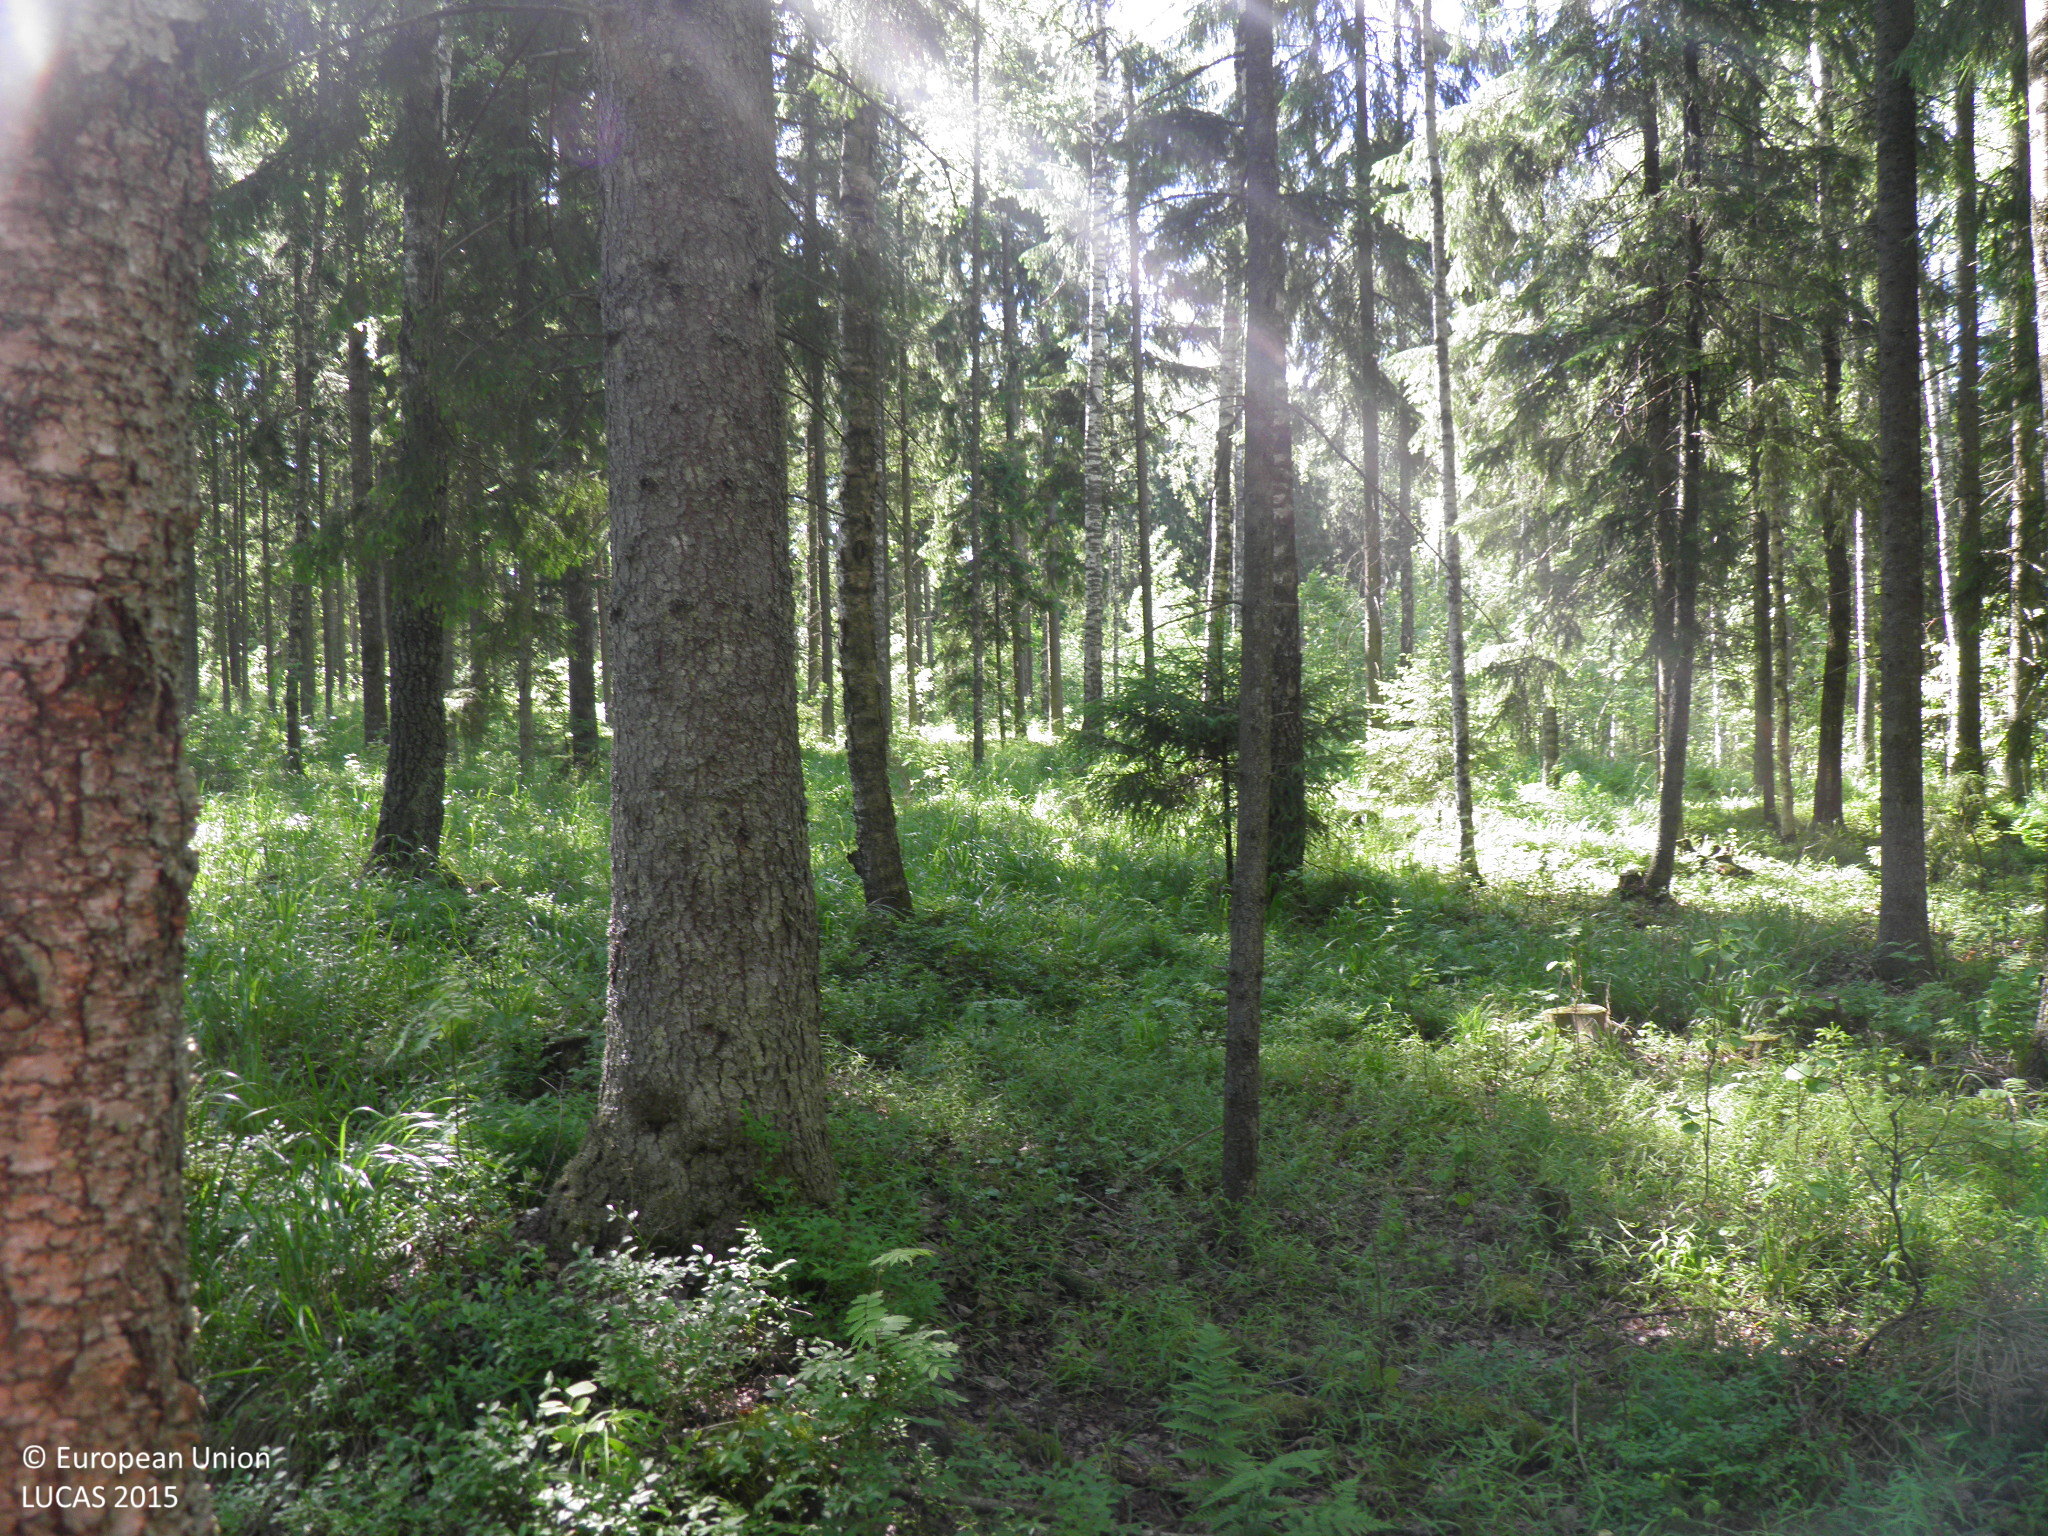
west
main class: Woodland
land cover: Spruce dominated mixed woodland
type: hemiboreal forest and nemoral coniferous forest and mixed broadleaved-coniferous forest
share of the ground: 50 - 75 %
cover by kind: coniferous forest trees 35 %, broadleaved forest trees 35 %, shrubs 10 %, herbaceous plants 10 %, unconsolidated bare surface 10 %
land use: Forestry
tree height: > 5 m
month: June
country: FI
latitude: 60.4661
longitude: 22.8612
